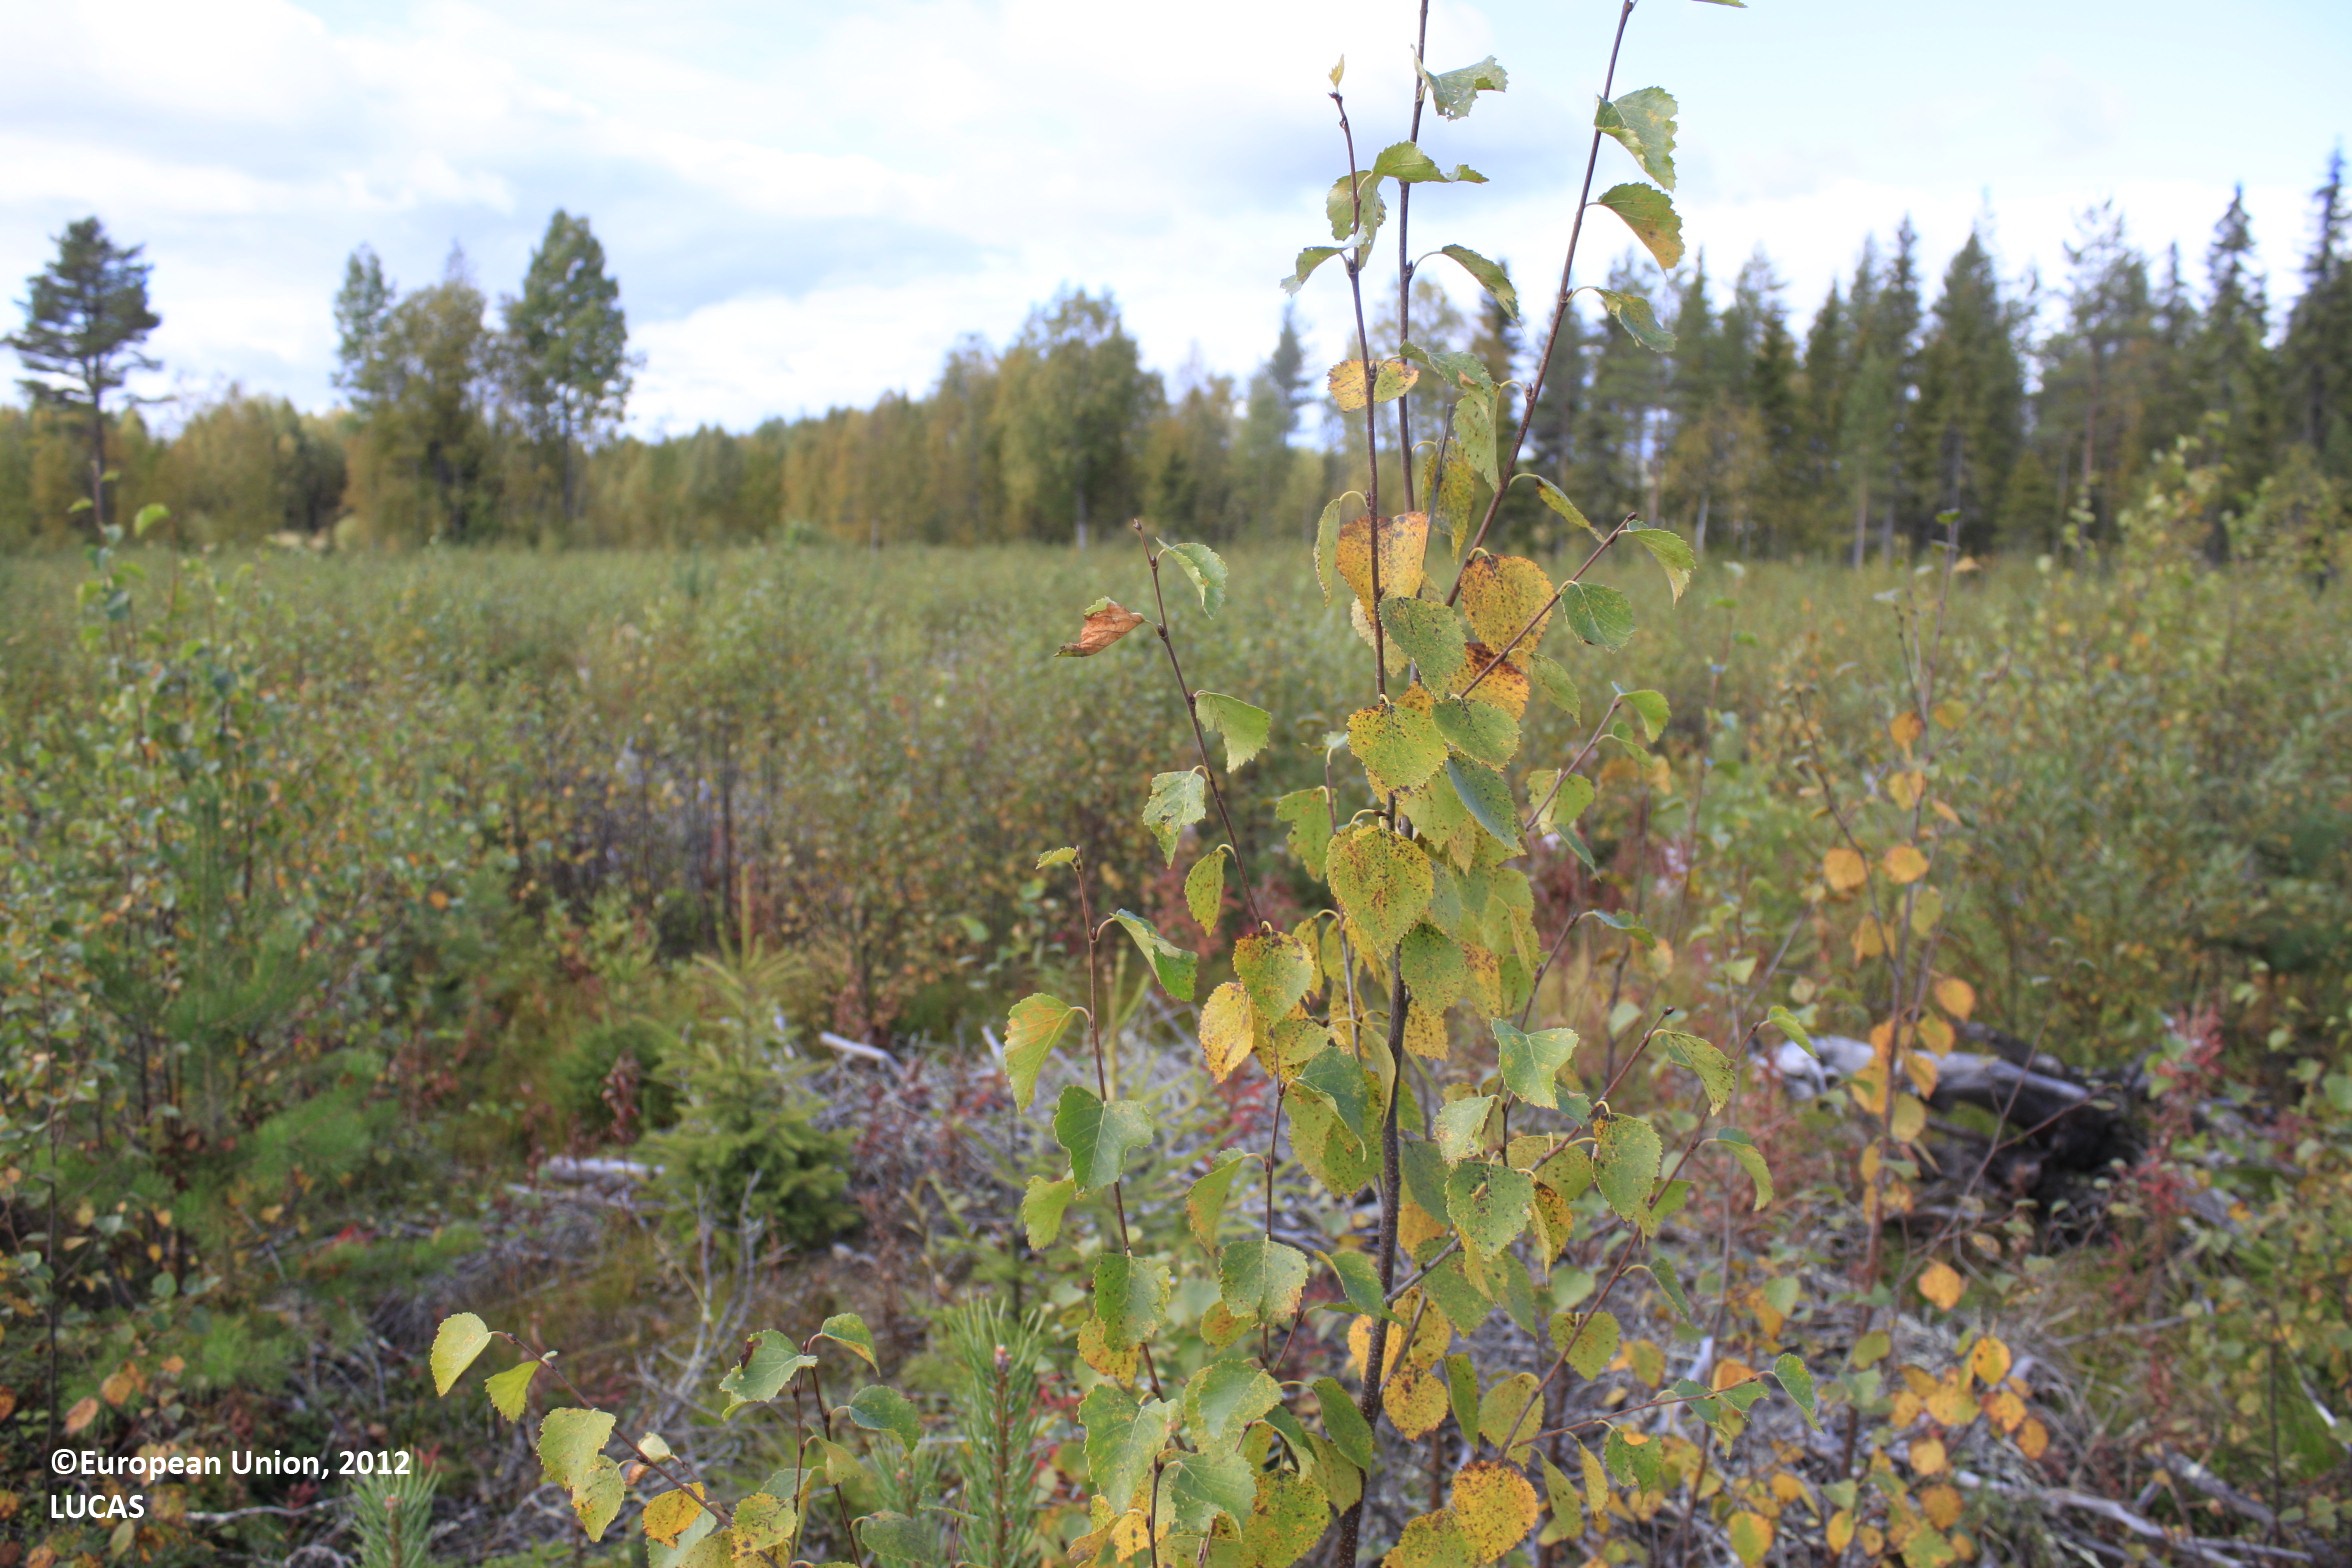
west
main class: Woodland
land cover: Broadleaved woodland
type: boreal forest
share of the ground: 25 - 50 %
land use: Forestry
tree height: < 5 m
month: September
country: FI
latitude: 65.6496
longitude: 26.5992
